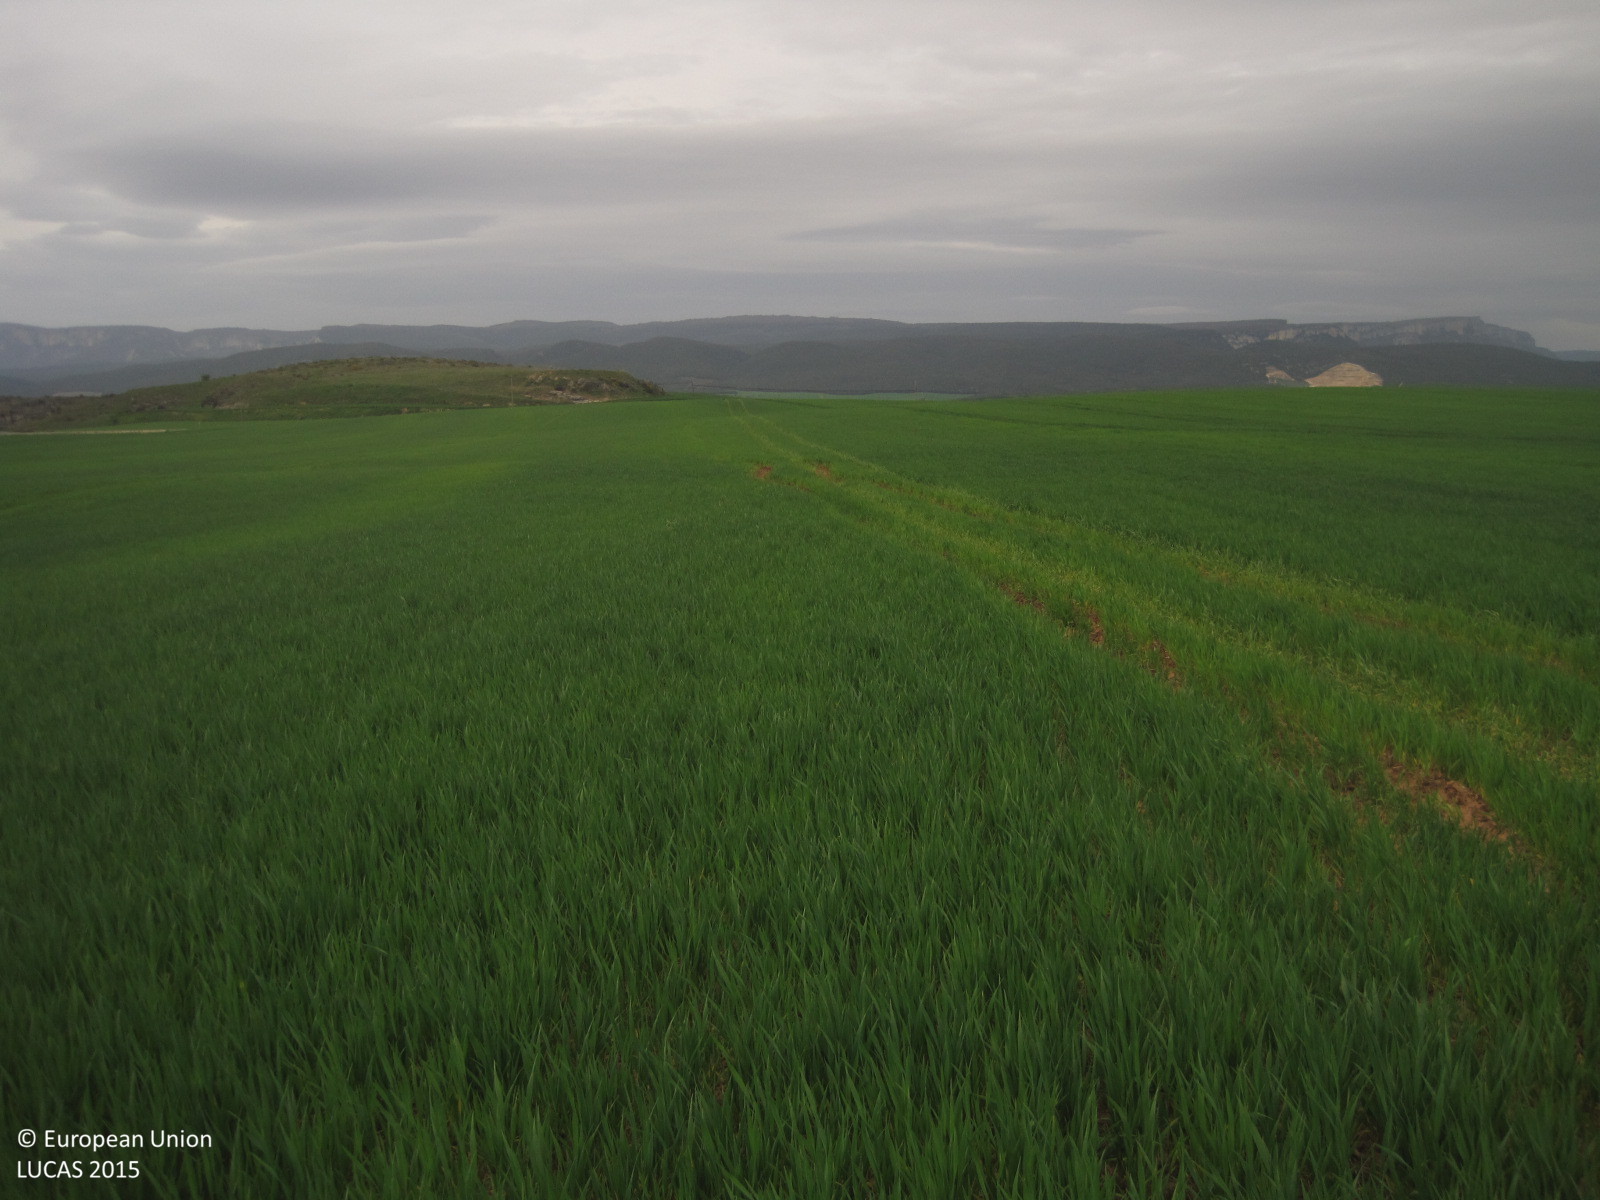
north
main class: Cropland
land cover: Barley
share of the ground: > 75 %
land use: Agriculture (excluding fallow land and kitchen gardens)
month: April
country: ES
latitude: 42.6279
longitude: -2.1756
